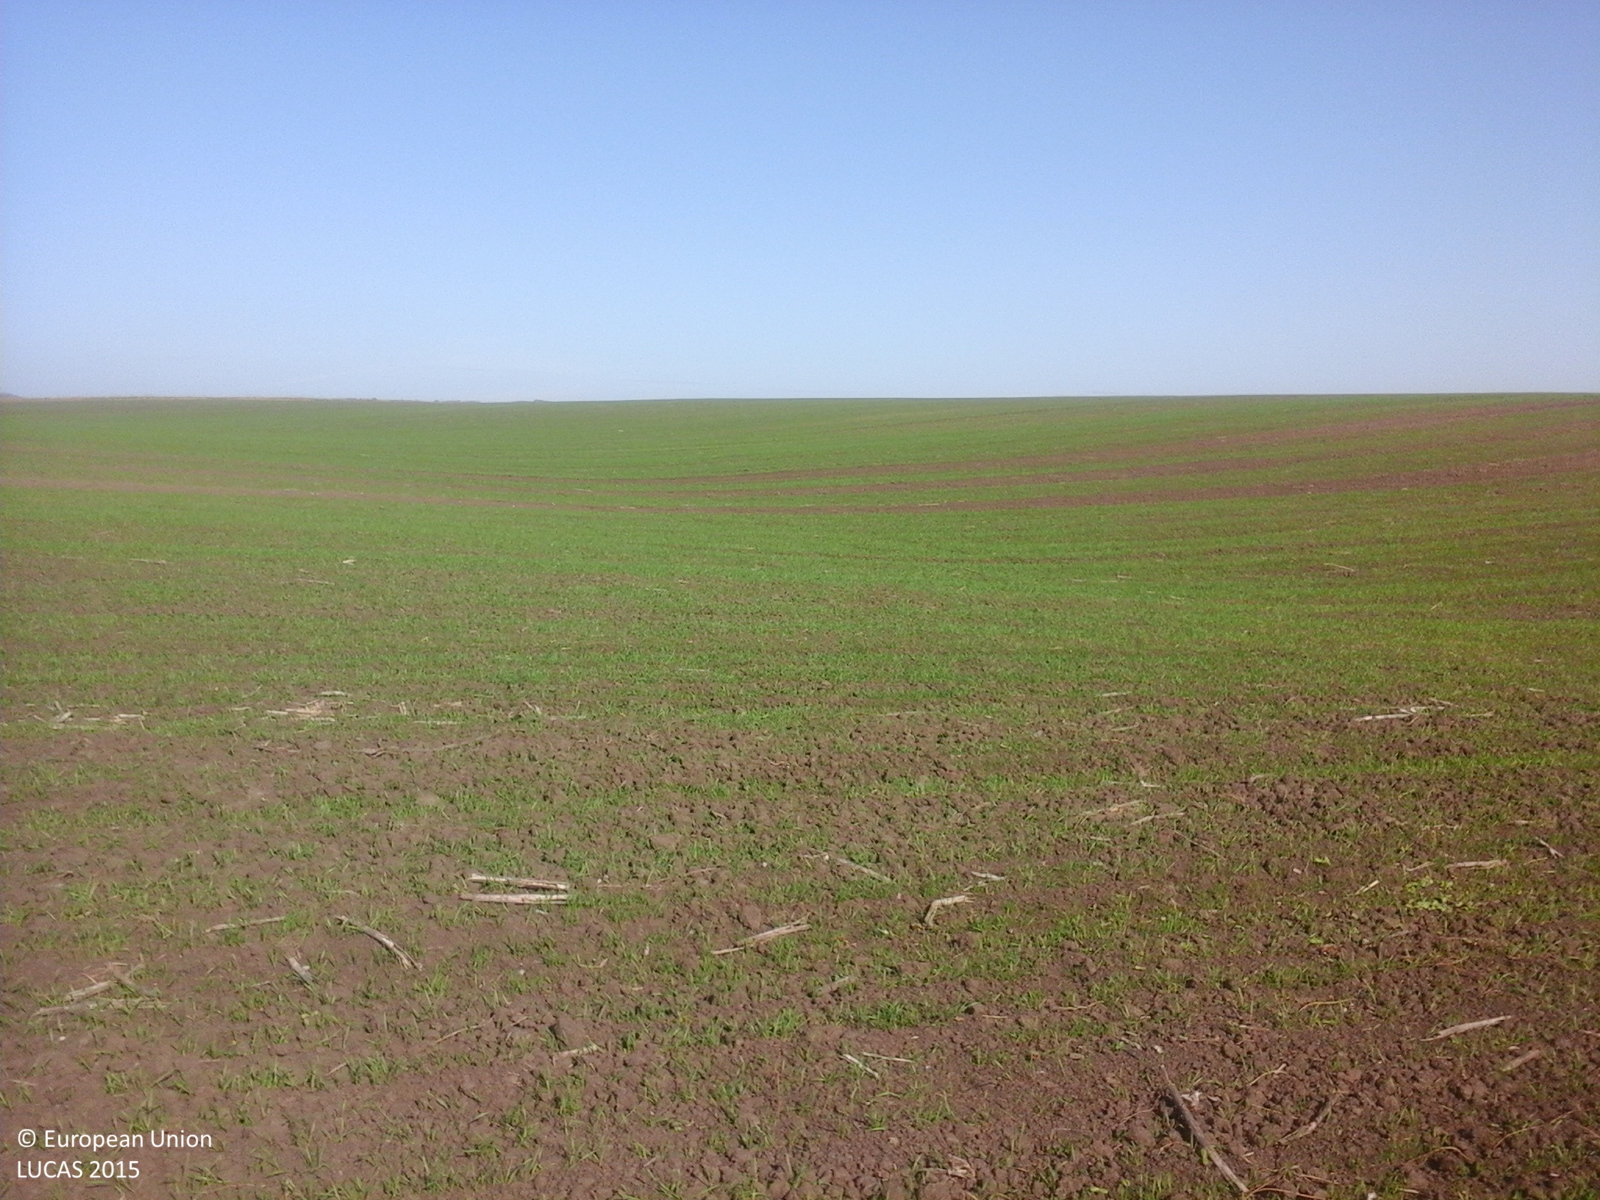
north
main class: Cropland
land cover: Common wheat
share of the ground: 50 - 75 %
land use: Agriculture (excluding fallow land and kitchen gardens)
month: October
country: RO
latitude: 45.2477
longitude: 26.8092
